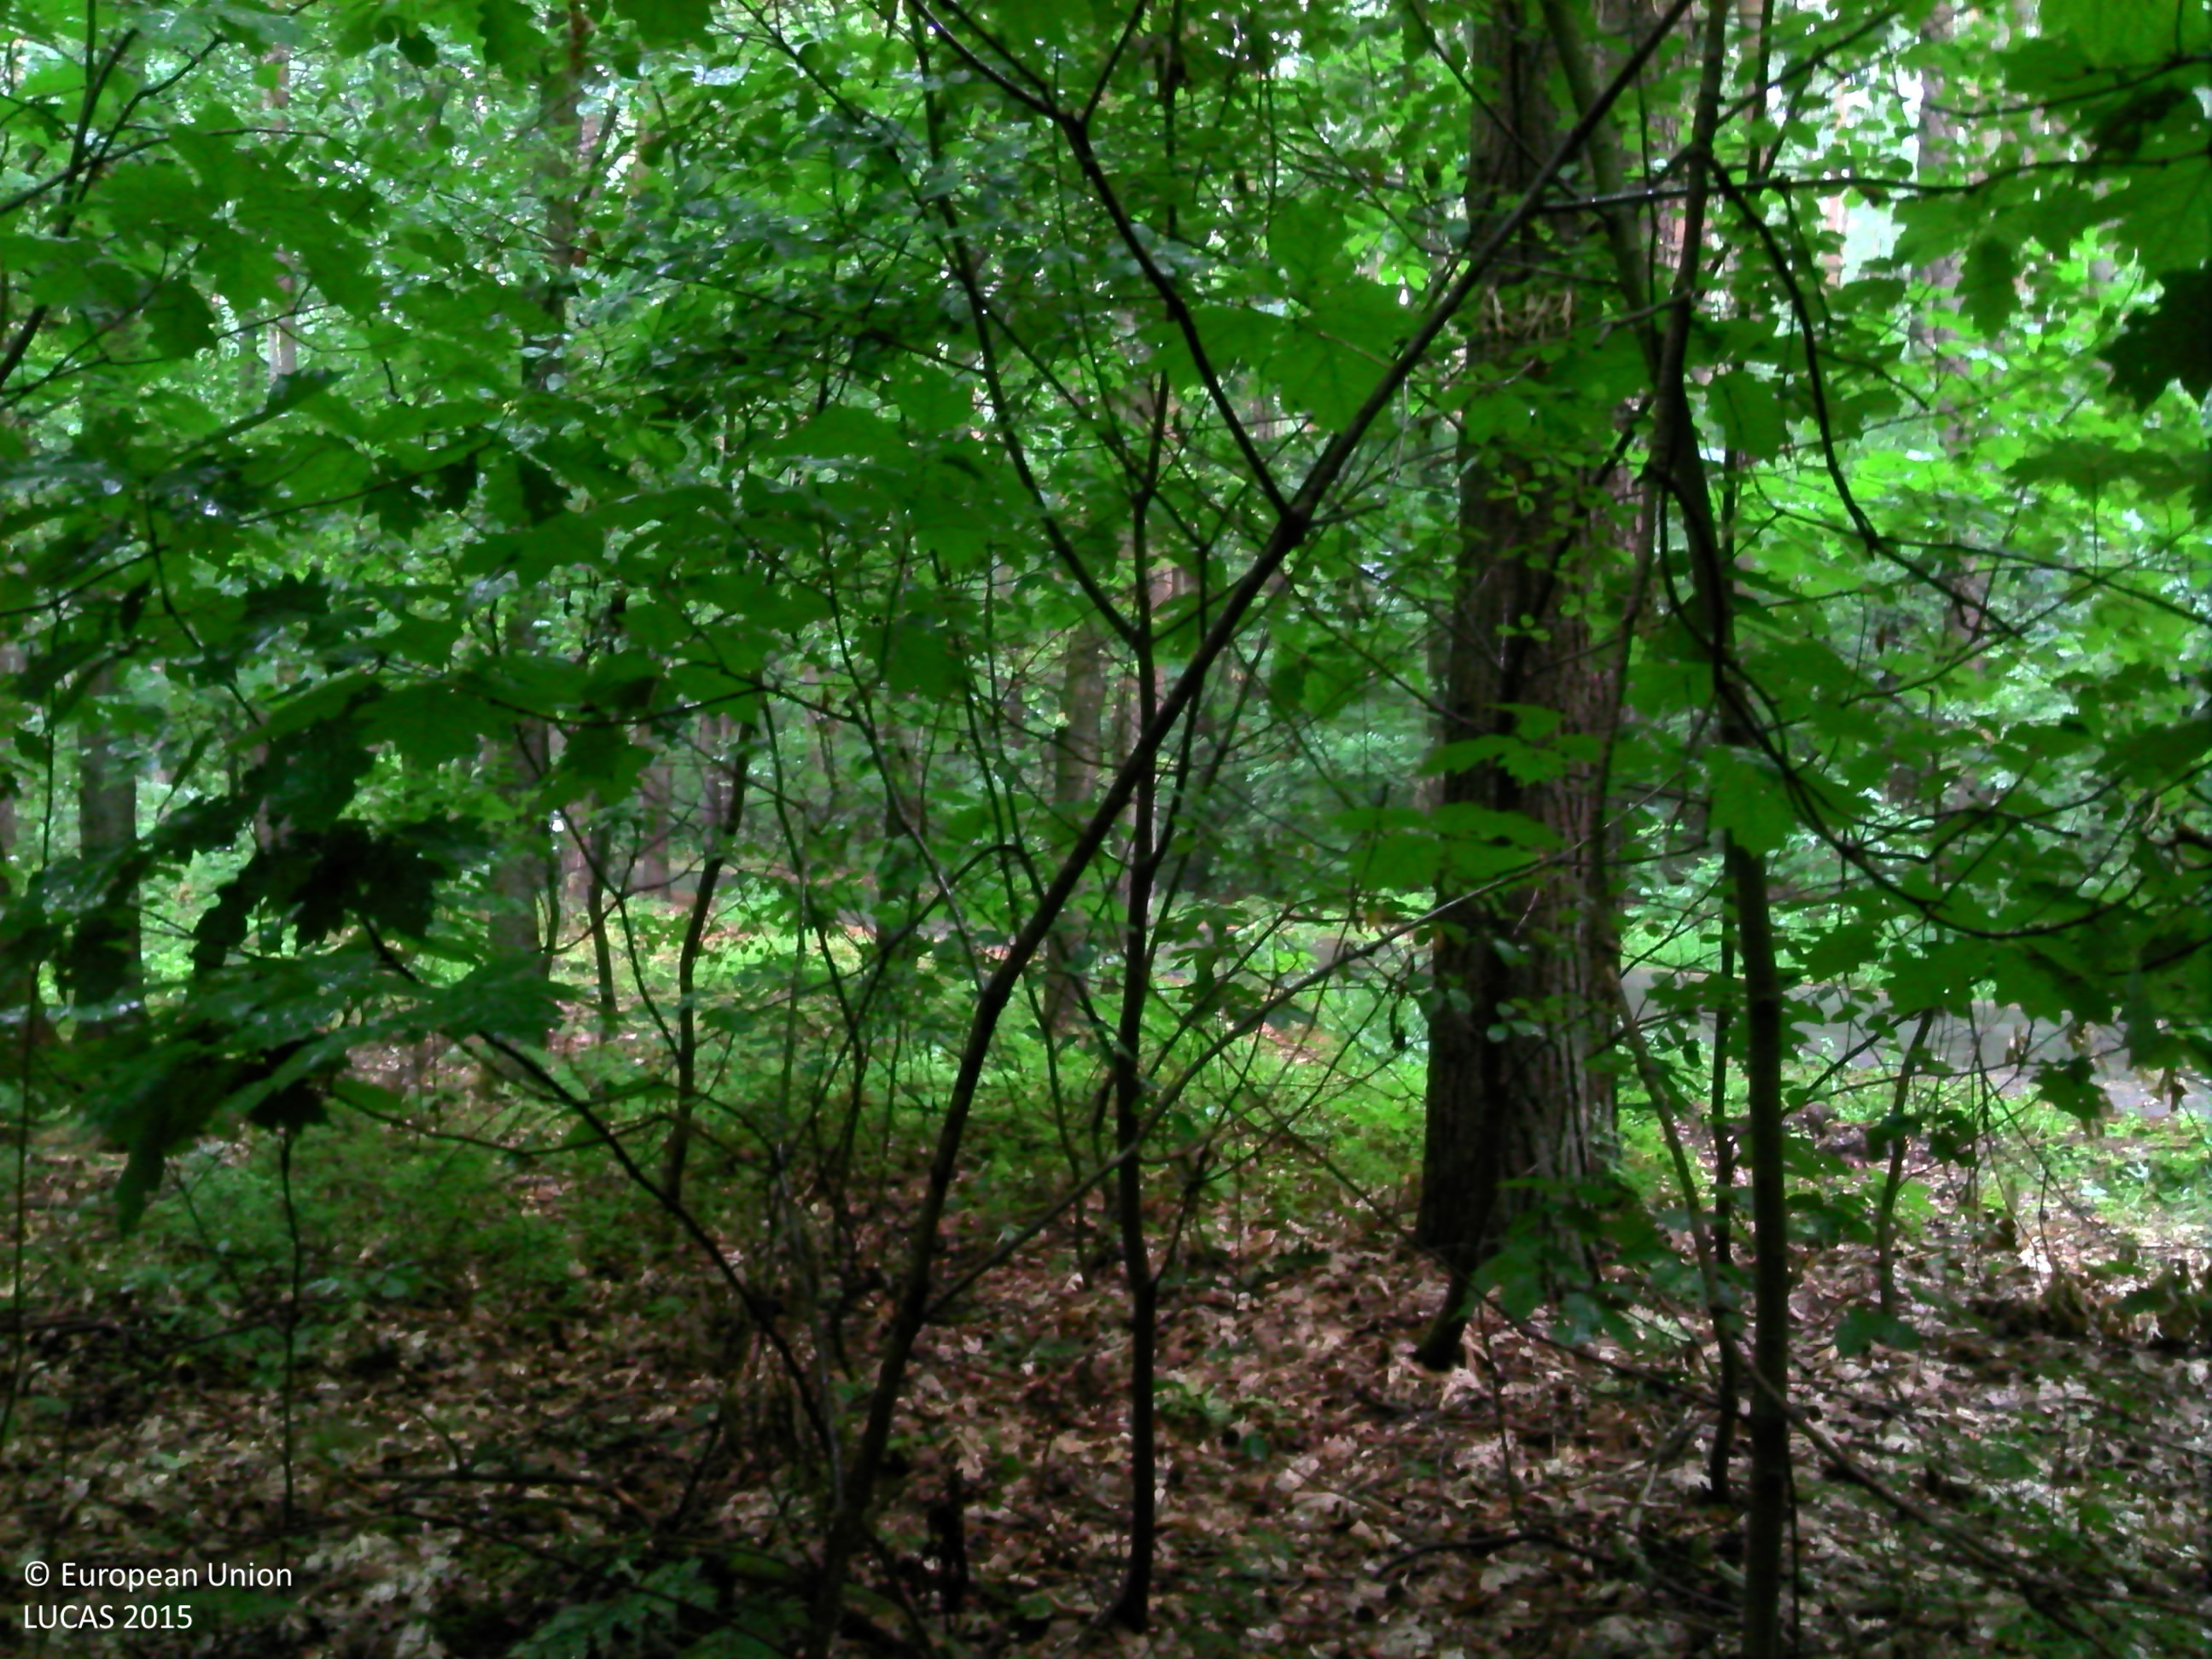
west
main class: Woodland
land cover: Pine dominated mixed woodland
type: hemiboreal forest and nemoral coniferous forest and mixed broadleaved-coniferous forest
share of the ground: > 75 %
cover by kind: coniferous forest trees 70 %, broadleaved forest trees 30 %
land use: Forestry
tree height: > 5 m
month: August
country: BE
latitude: 50.9446
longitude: 5.5719
